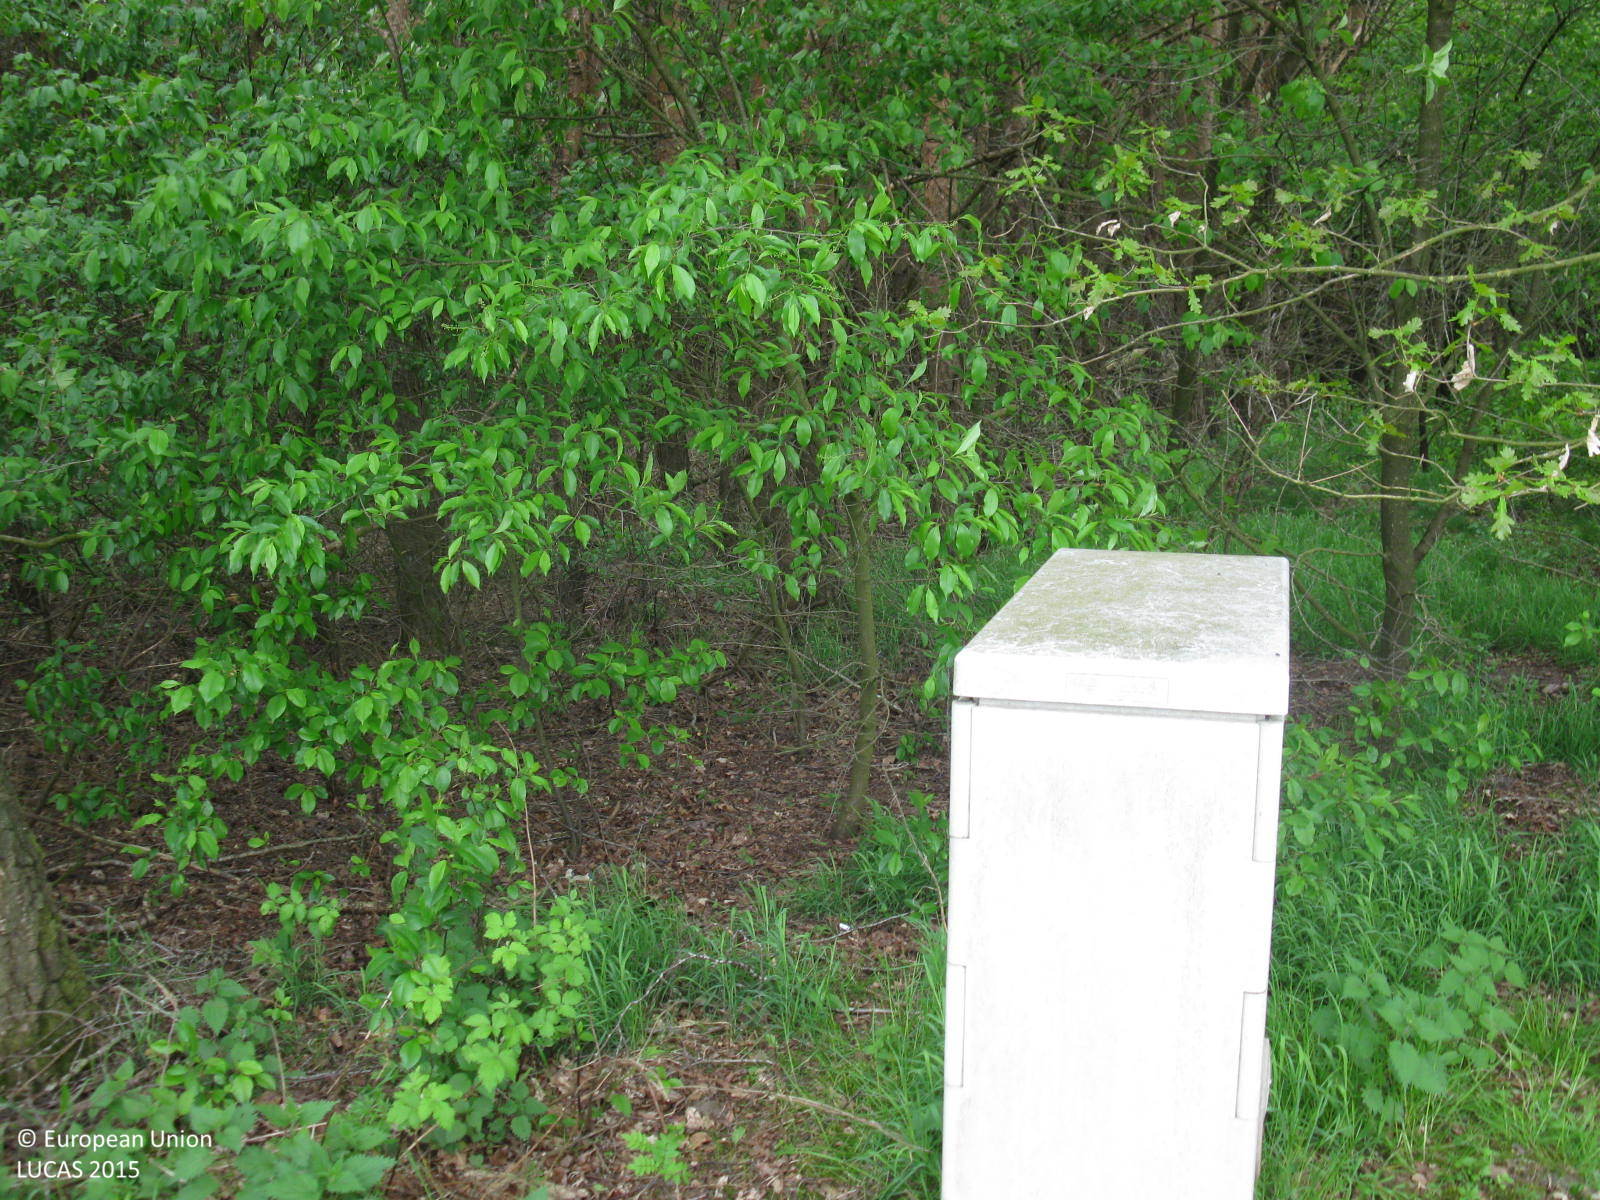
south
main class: Grassland
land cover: Spontaneously vegetated surfaces
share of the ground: > 75 %
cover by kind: herbaceous plants 100 %
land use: Semi-natural and natural areas not in use
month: May
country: DE
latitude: 52.7974
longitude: 7.3456
